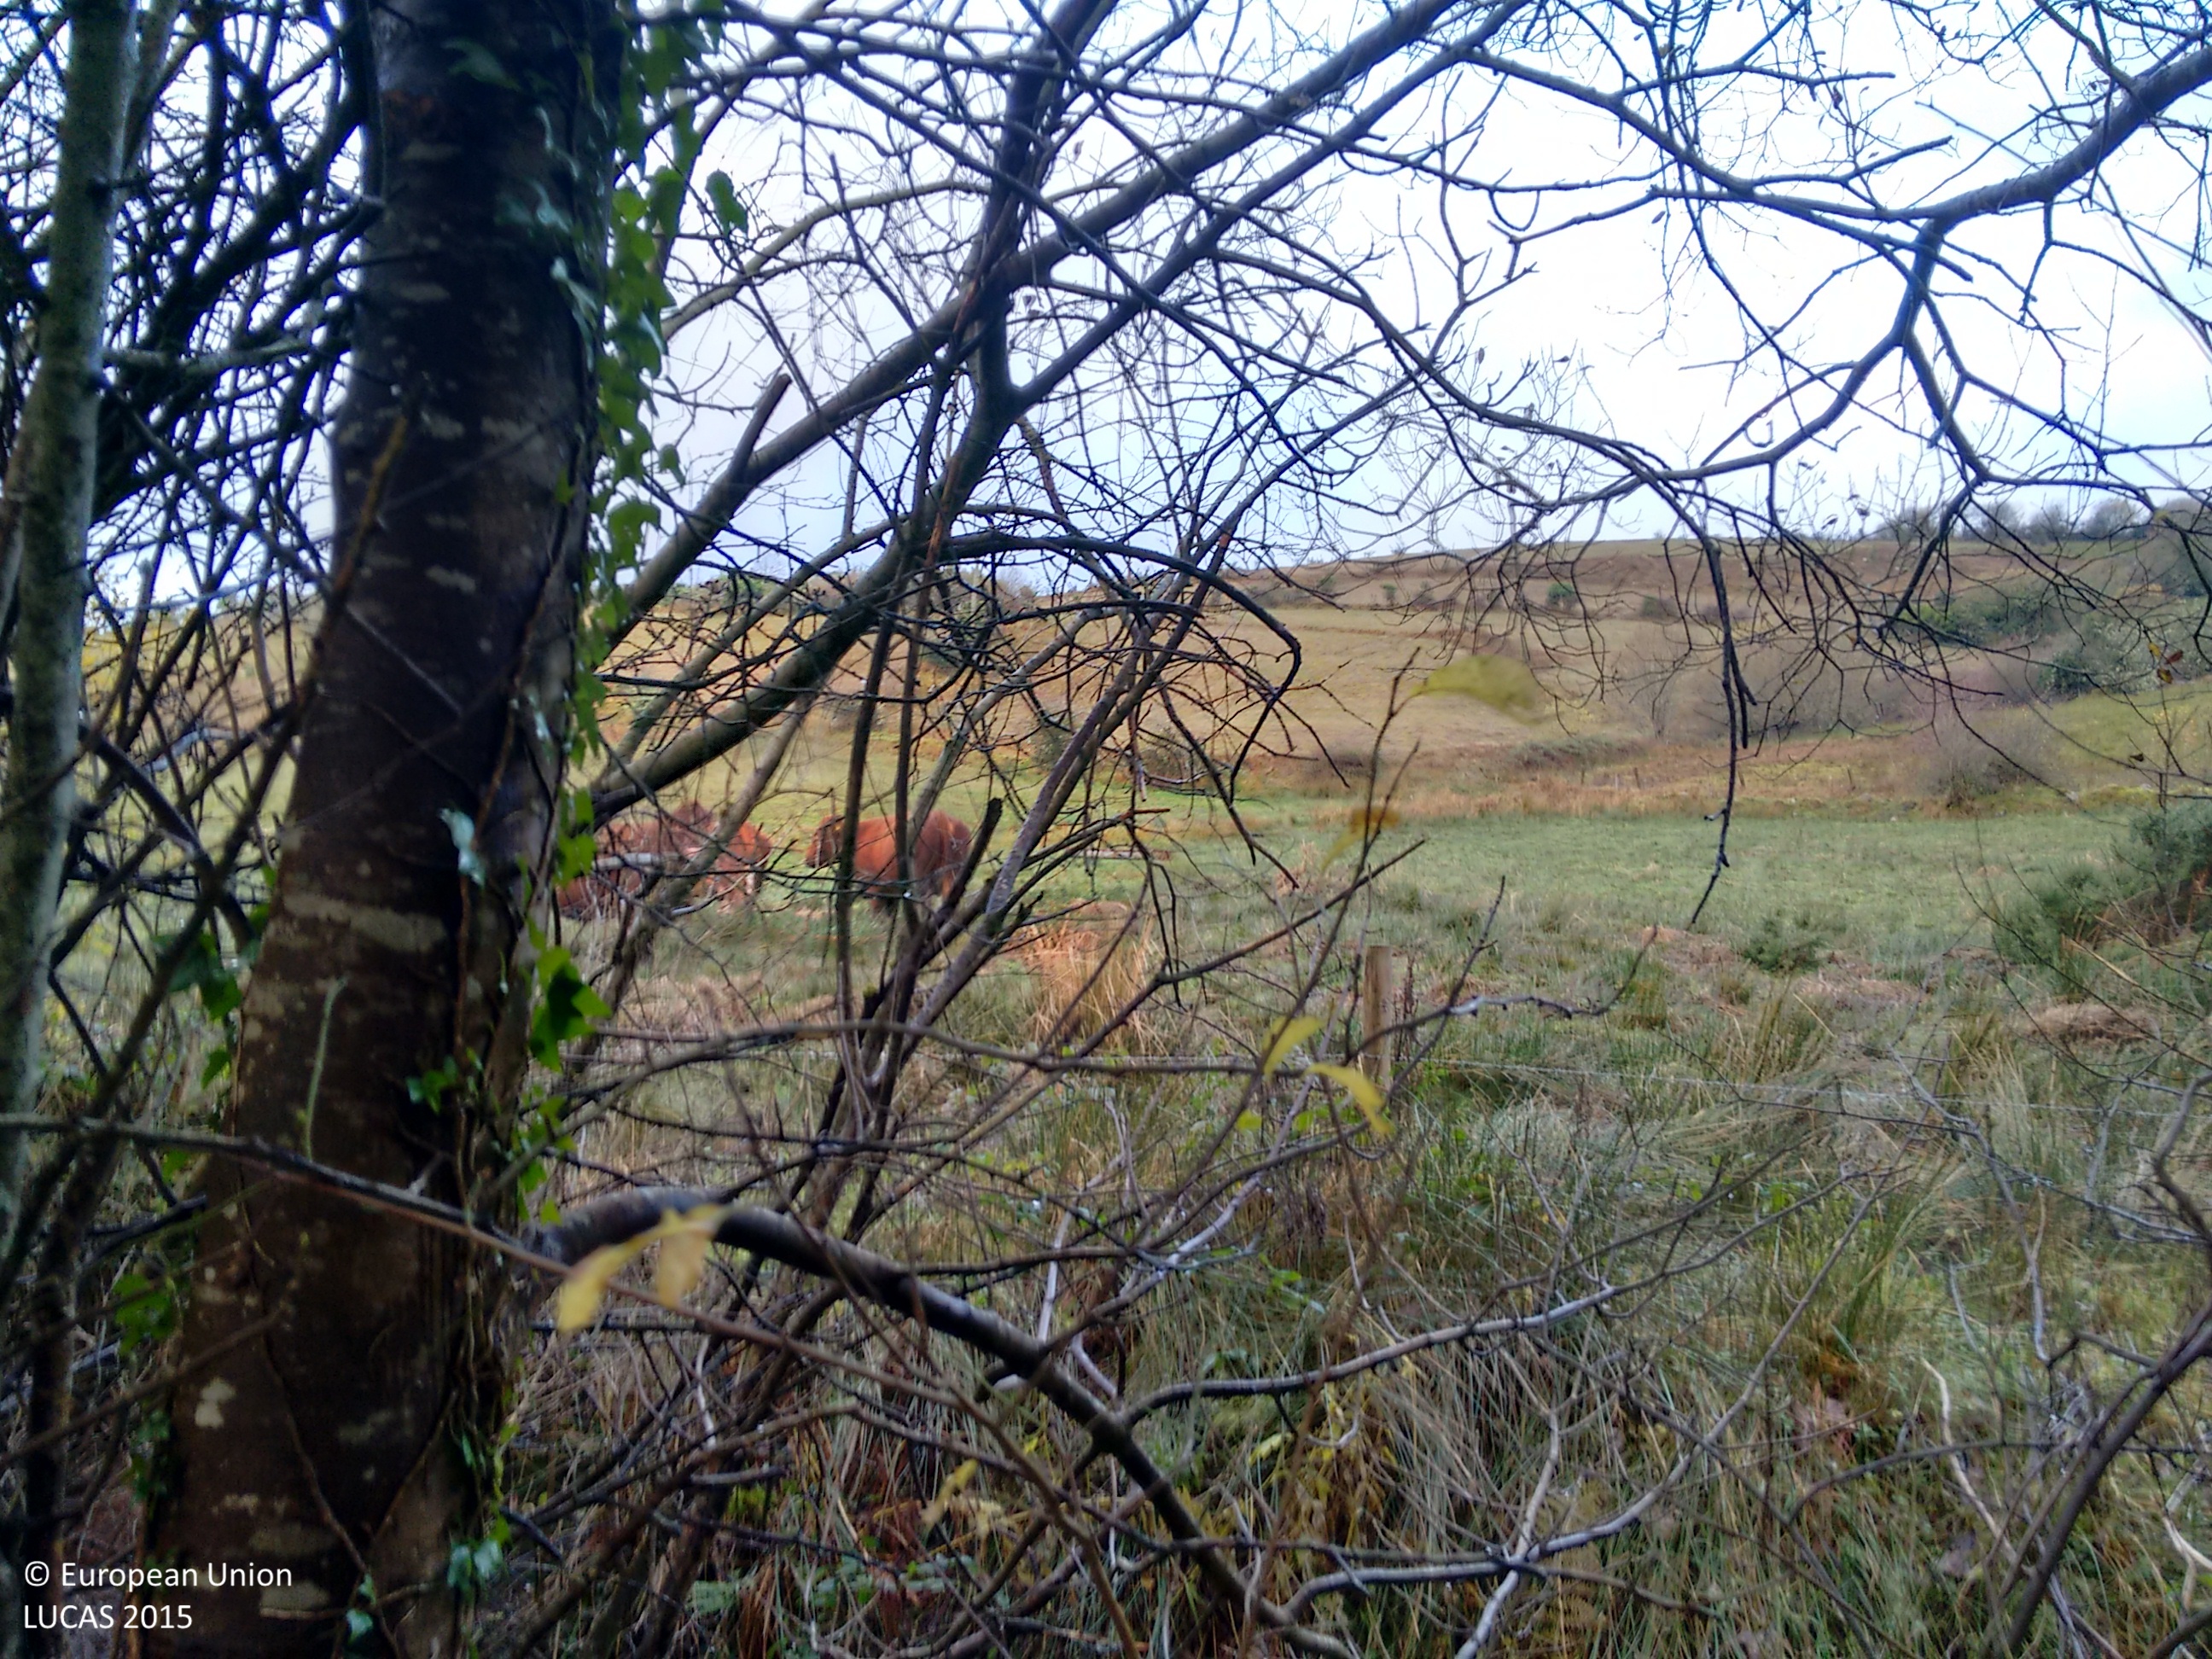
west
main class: Grassland
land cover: Grassland without tree/shrub cover
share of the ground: > 75 %
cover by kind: herbaceous plants 100 %
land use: Agriculture (excluding fallow land and kitchen gardens)
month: December
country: IE
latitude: 54.2134
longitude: -8.0077
